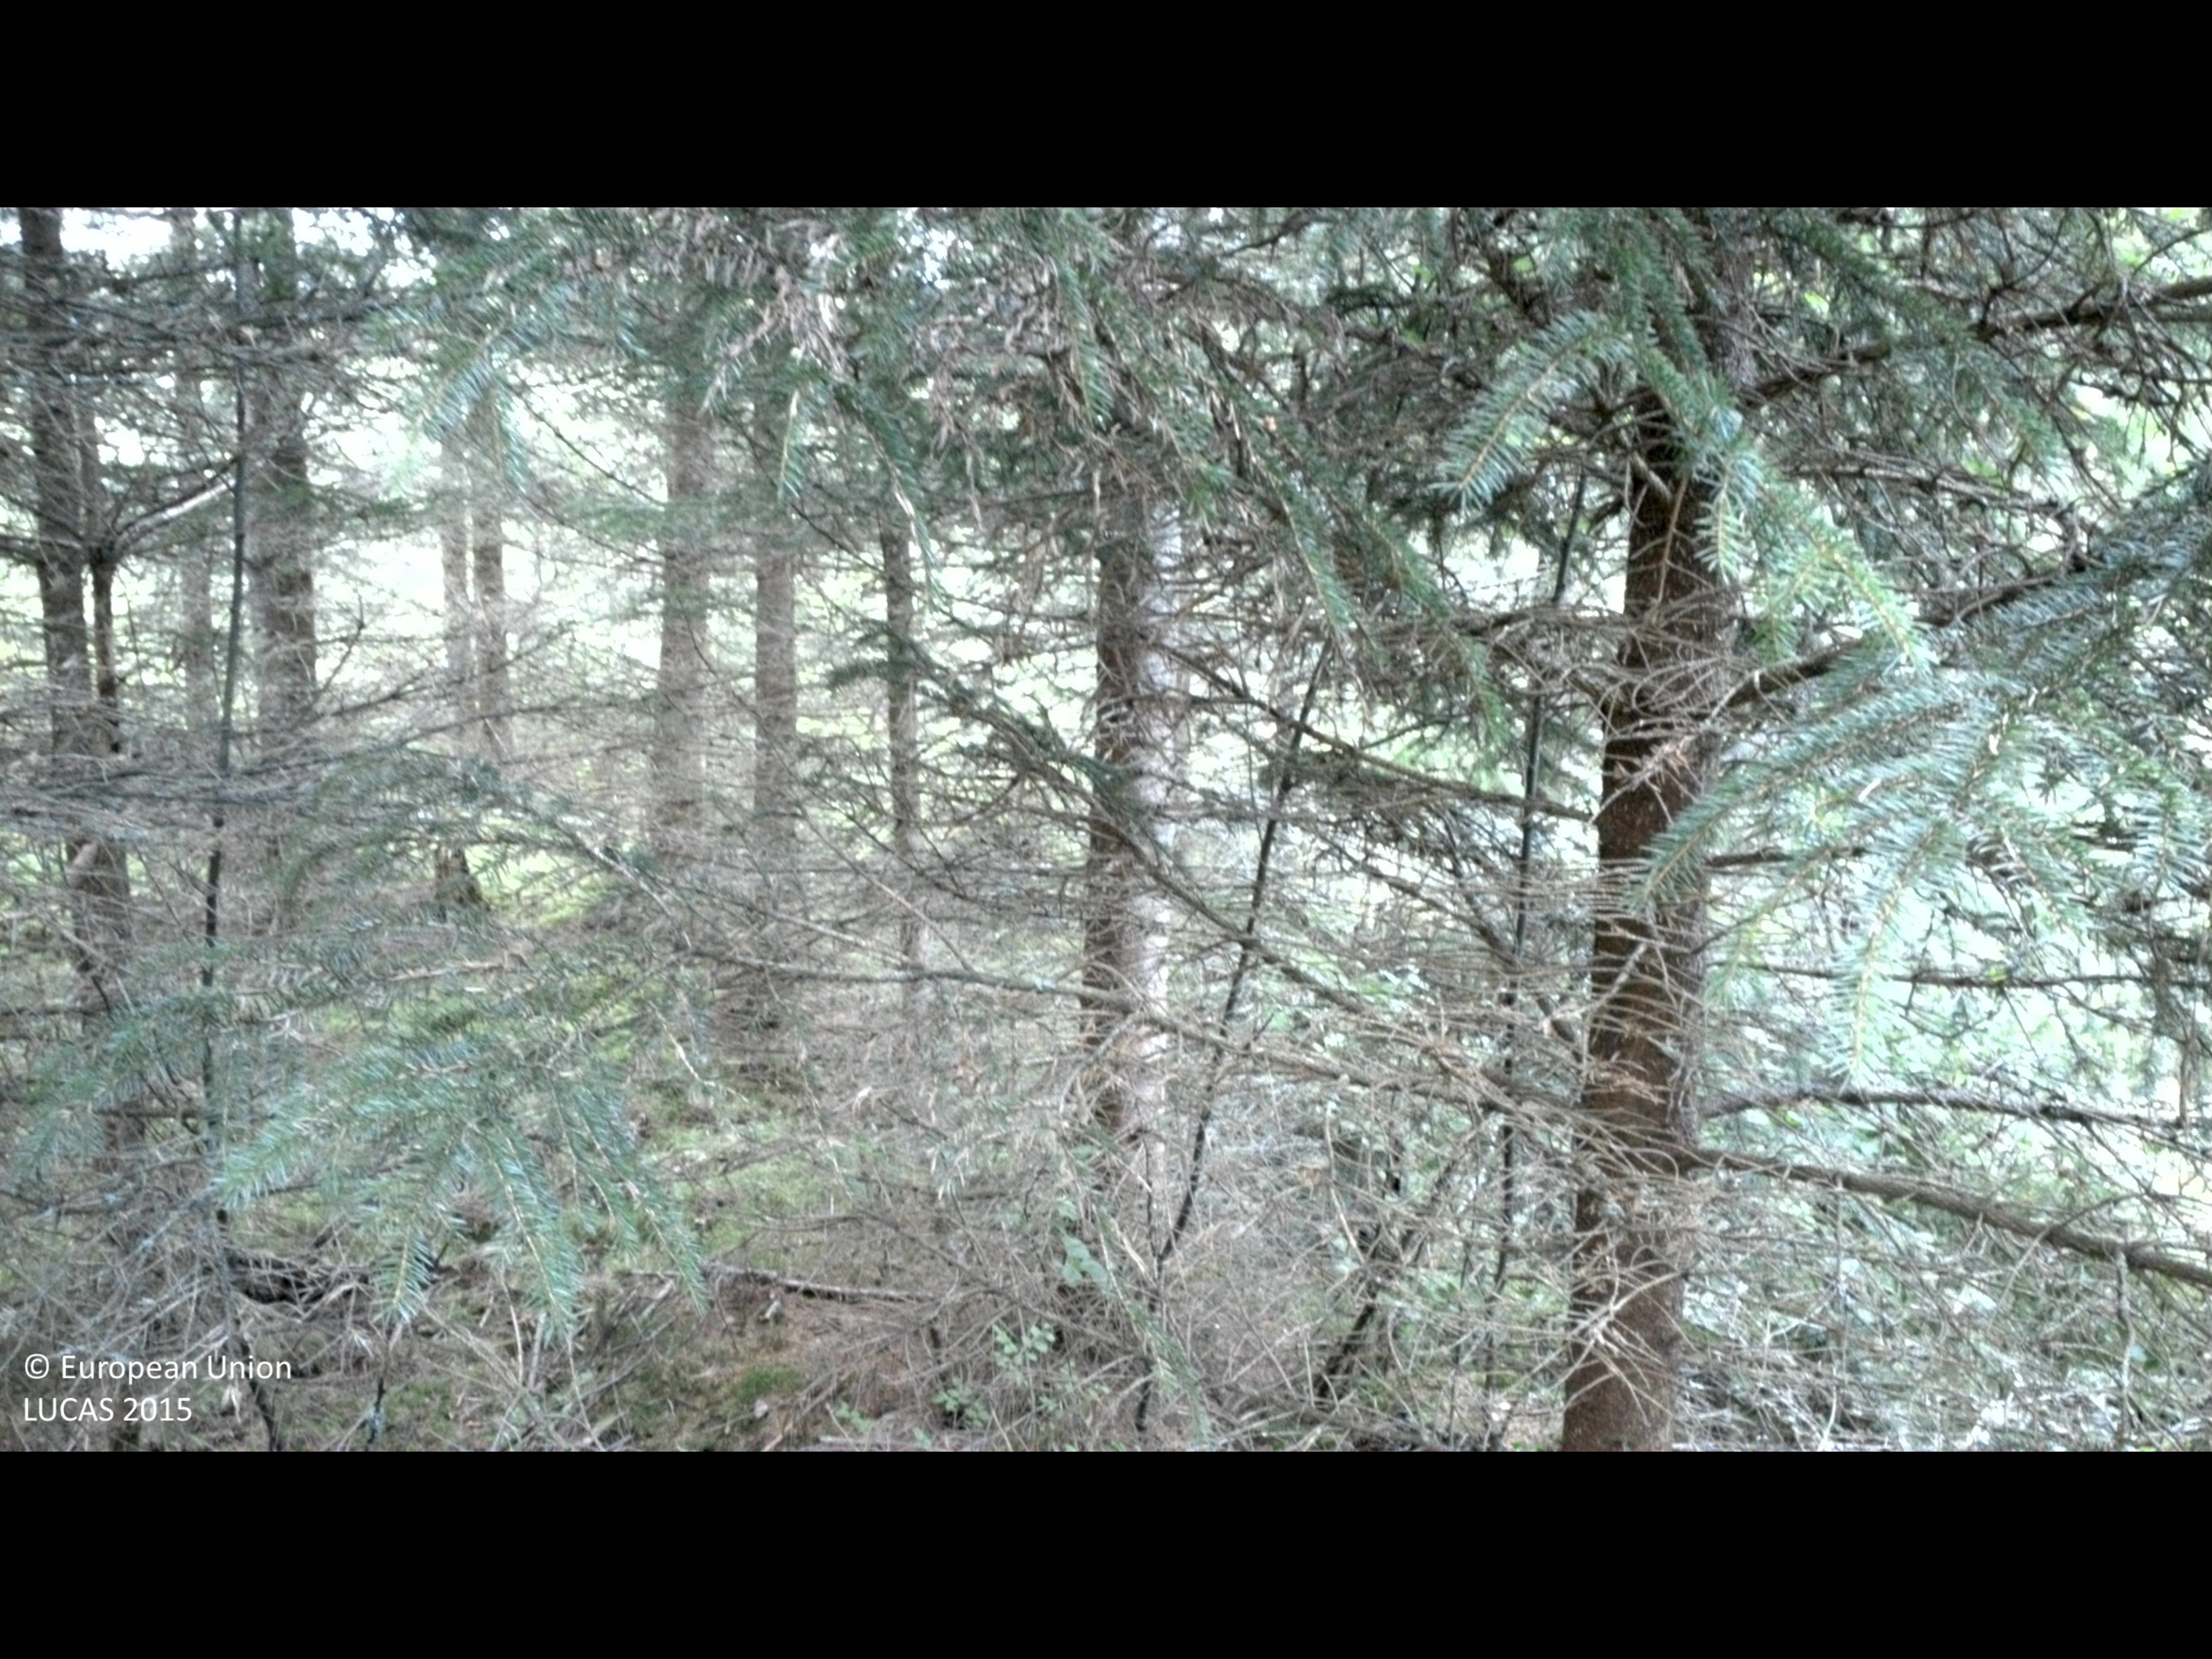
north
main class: Woodland
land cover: Spruce dominated mixed woodland
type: boreal forest
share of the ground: > 75 %
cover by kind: coniferous forest trees 60 %, broadleaved forest trees 20 %, shrubs 20 %
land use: Forestry
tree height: > 5 m
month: July
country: SE
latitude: 56.4911
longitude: 13.8138
